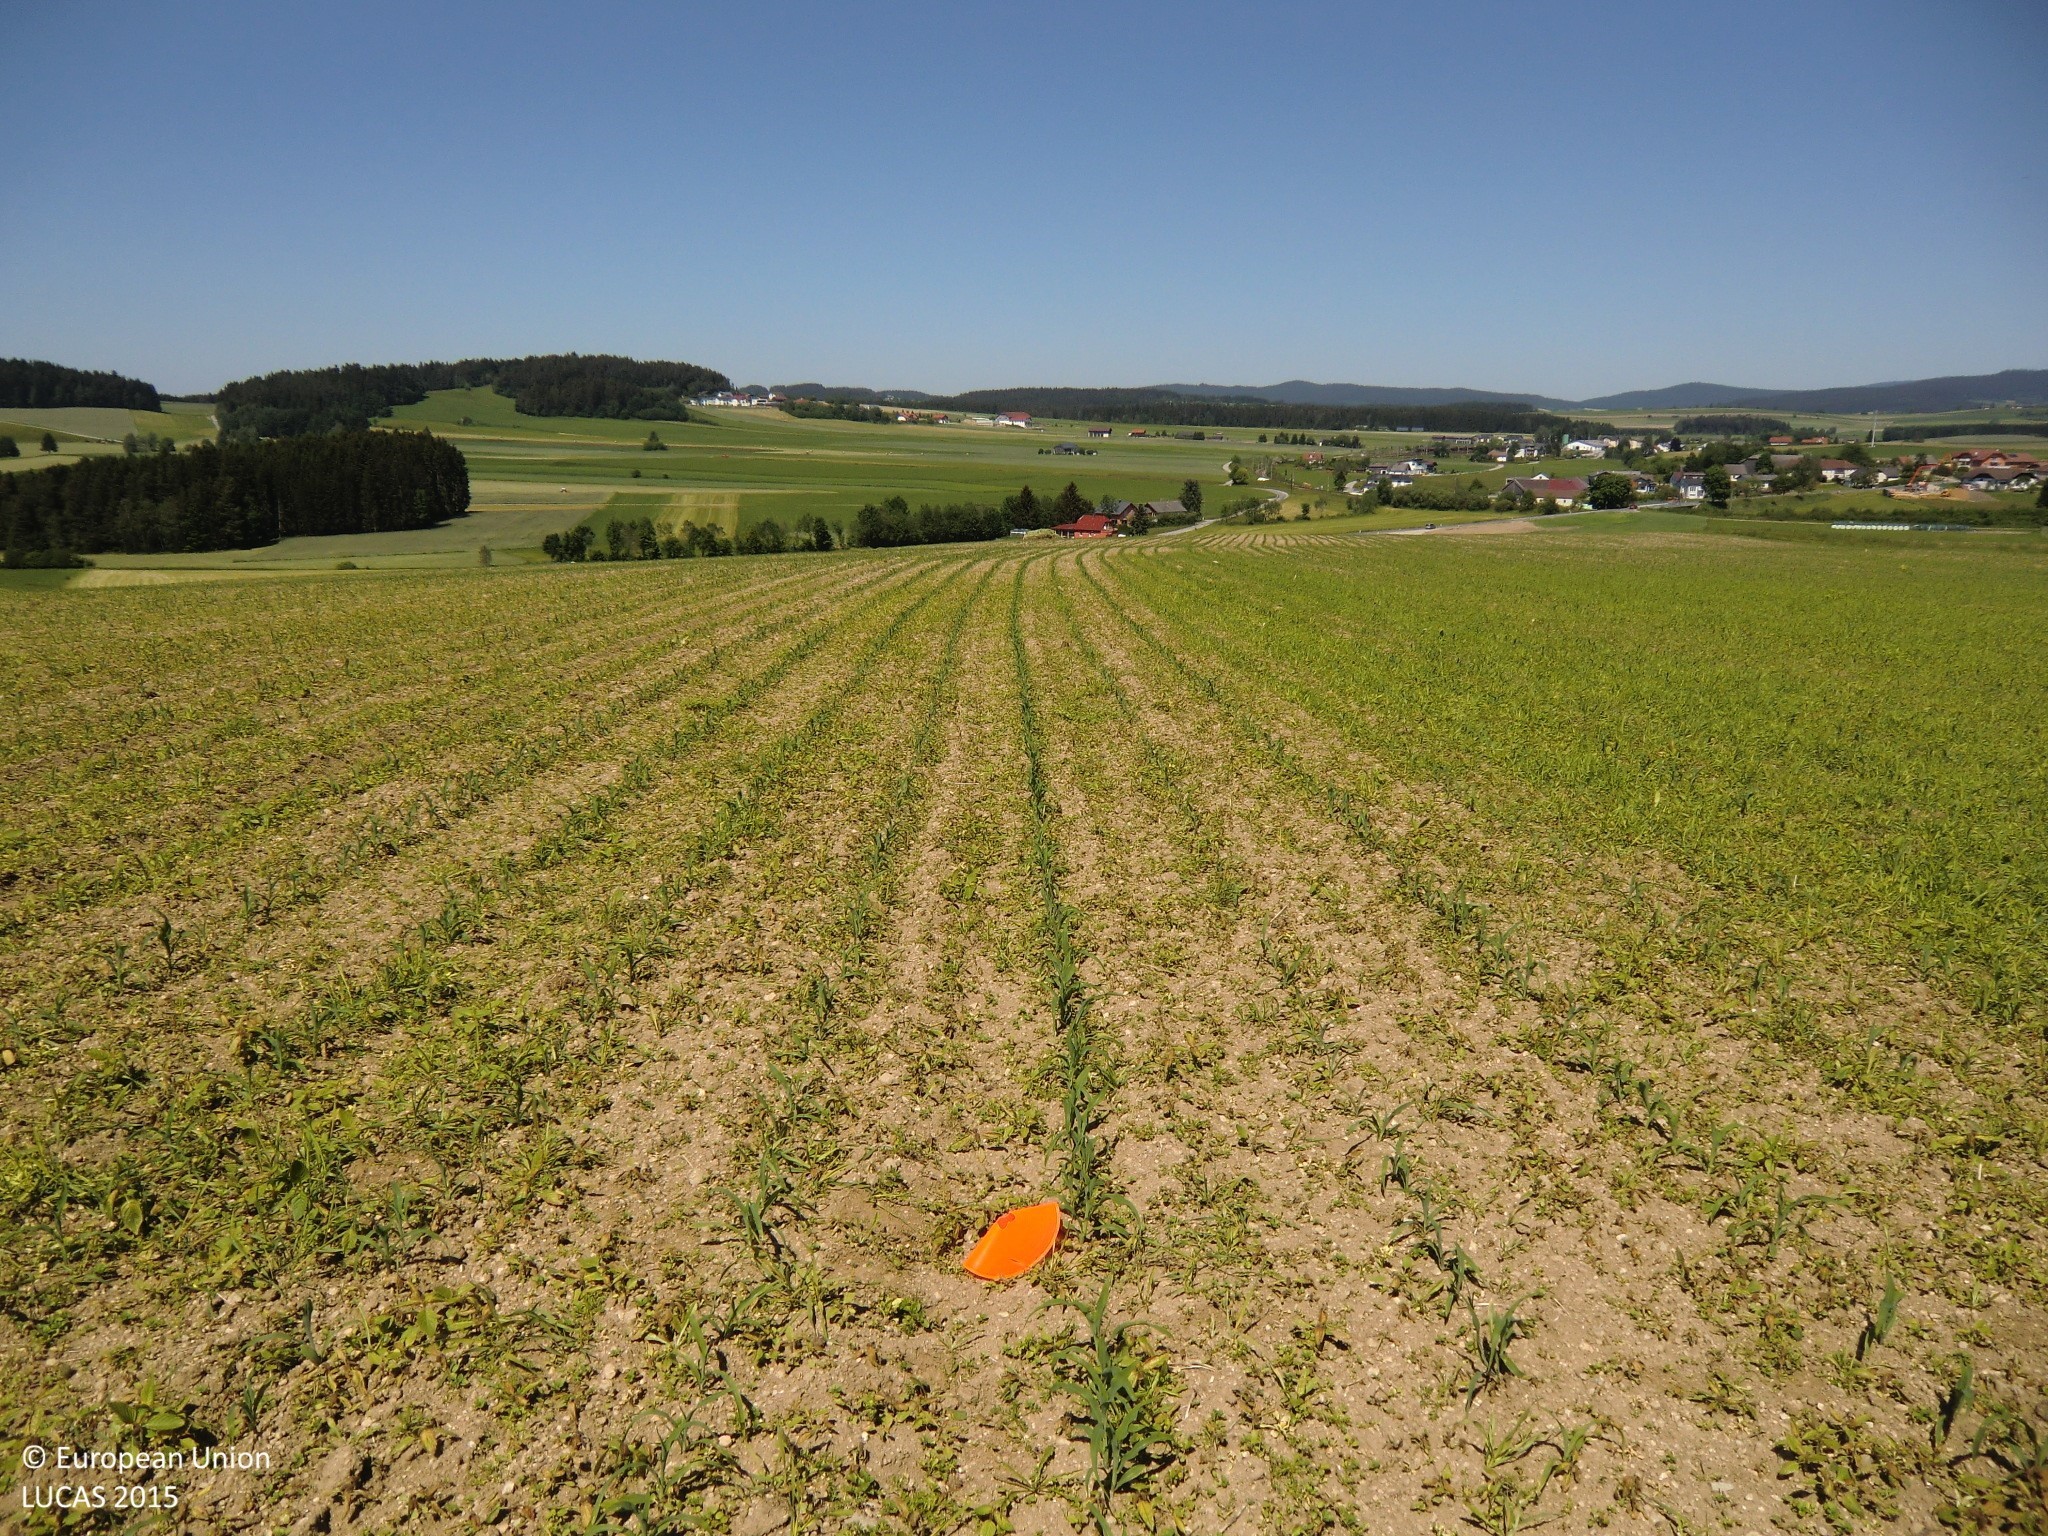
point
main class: Cropland
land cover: Maize
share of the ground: 25 - 50 %
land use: Agriculture (excluding fallow land and kitchen gardens)
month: June
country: AT
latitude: 48.5490
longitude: 14.4304
